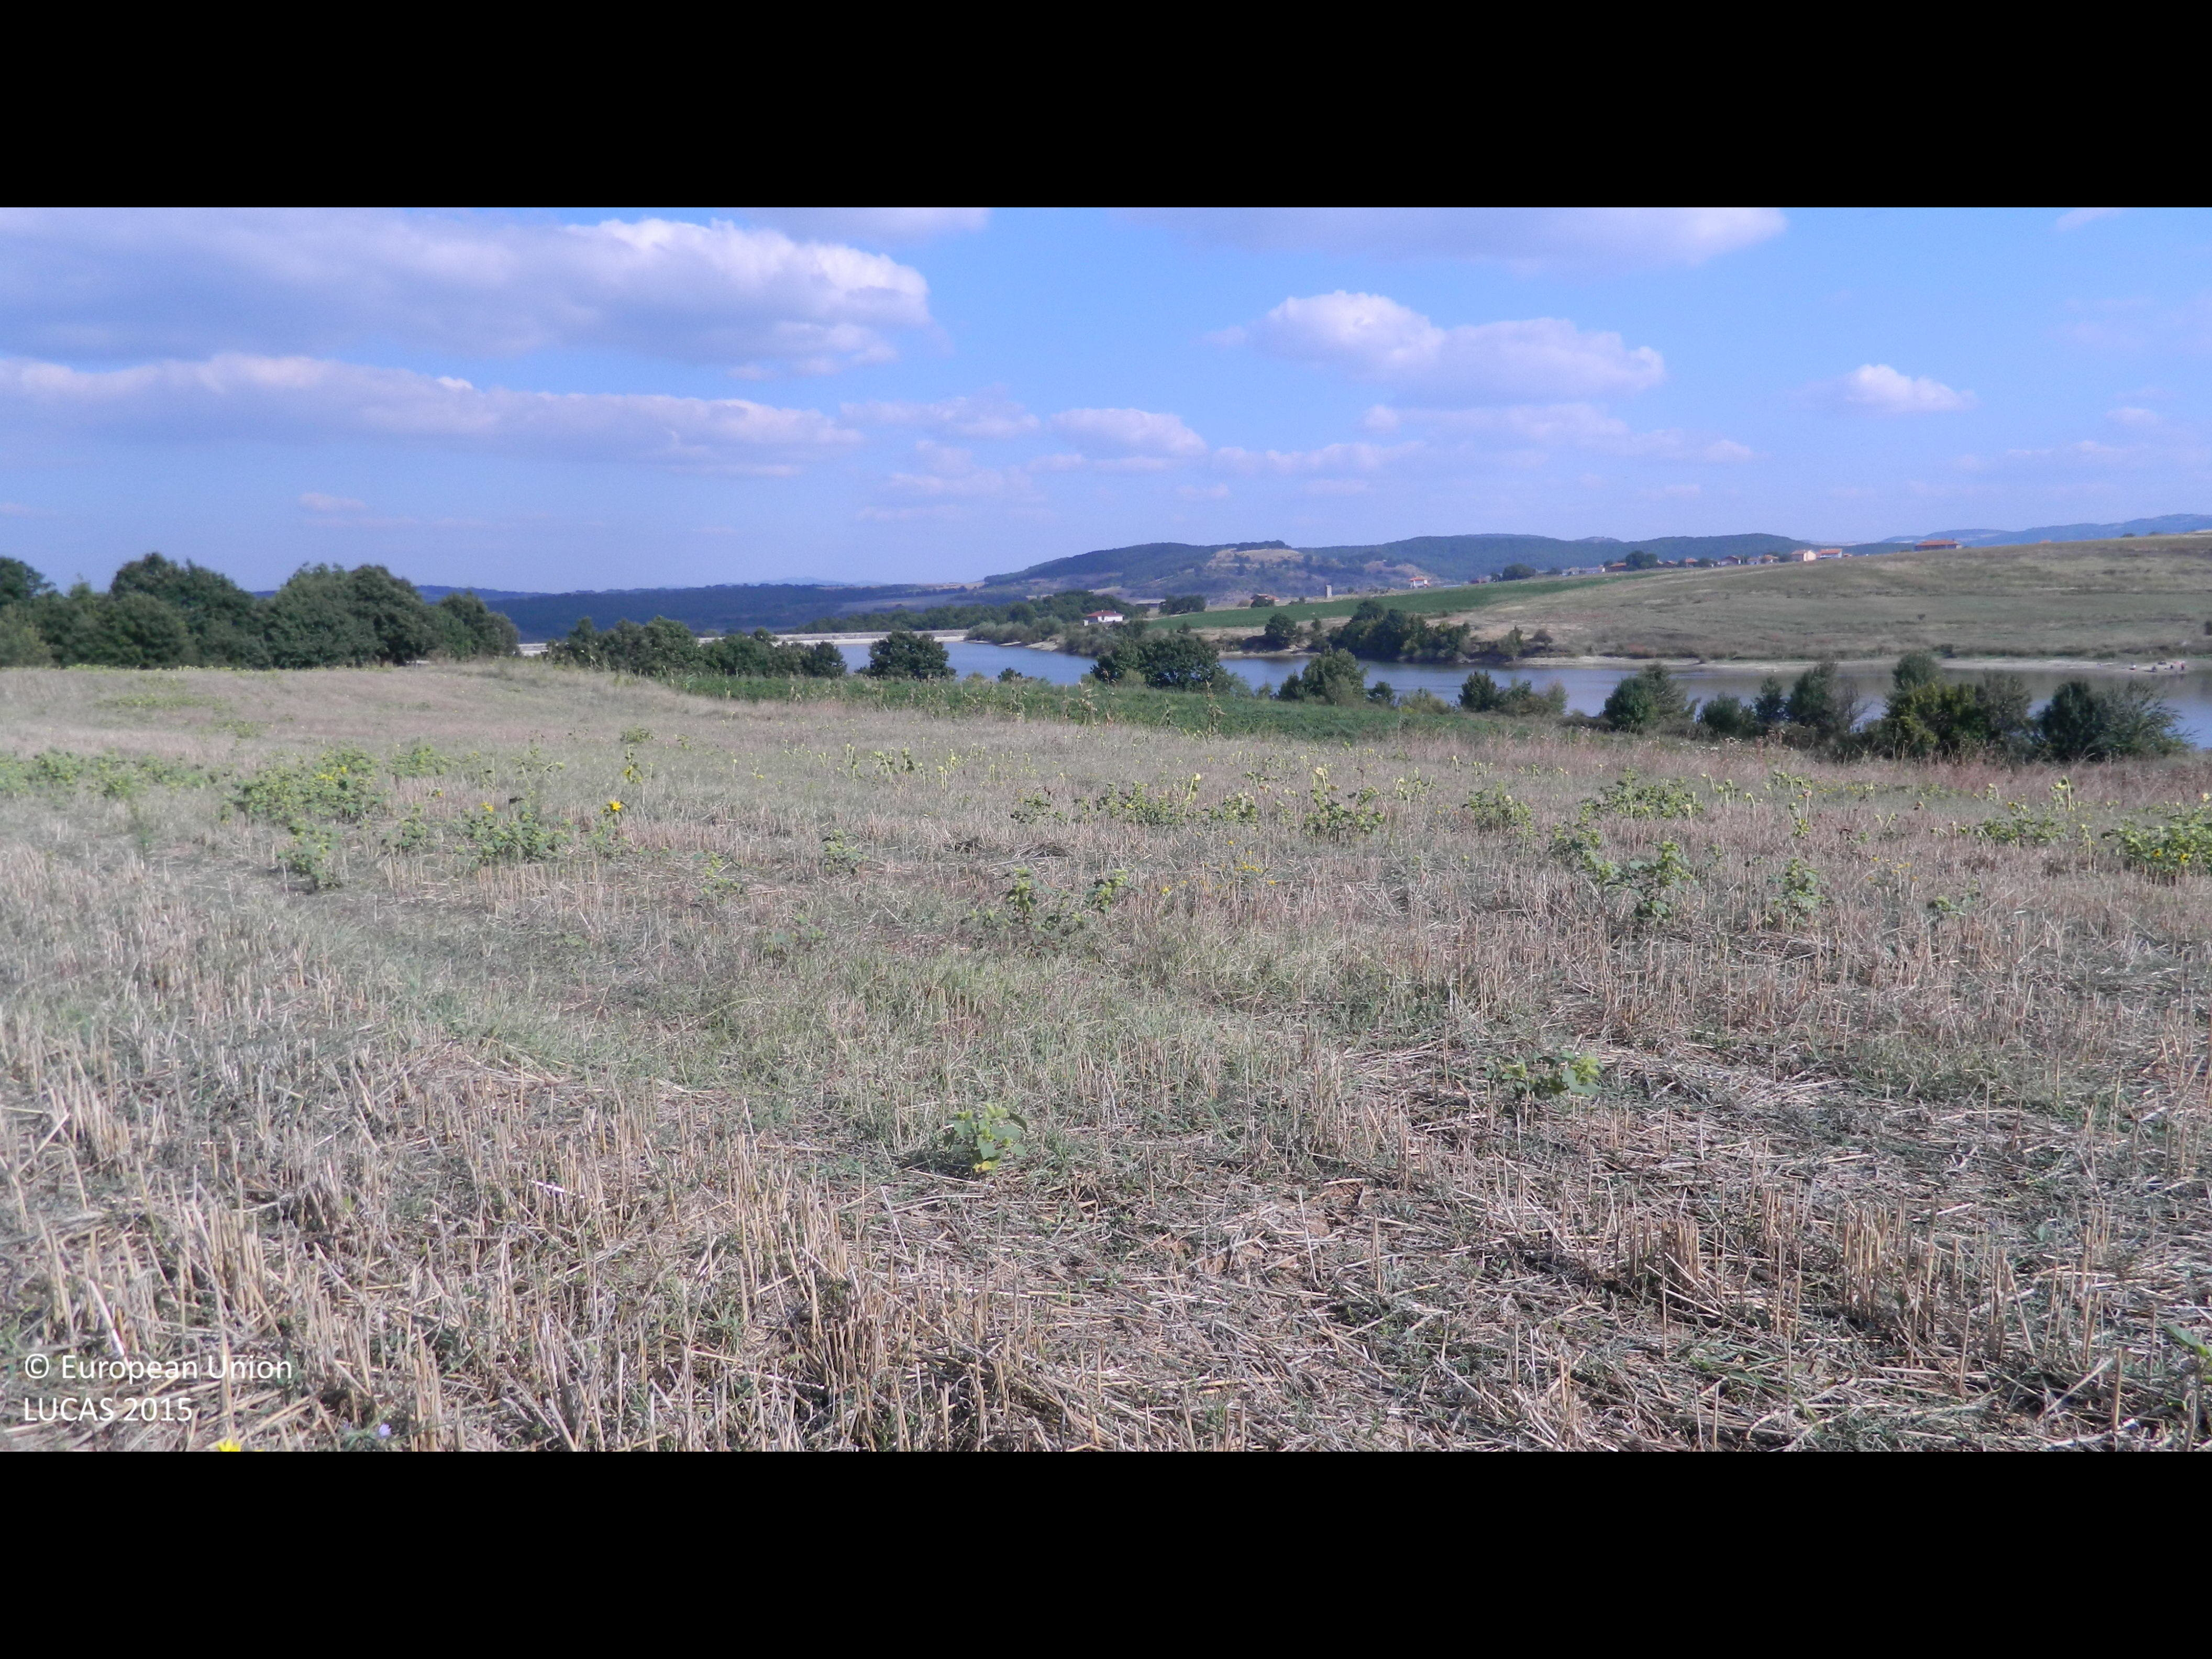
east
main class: Cropland
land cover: Common wheat
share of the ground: < 10 %
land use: Agriculture (excluding fallow land and kitchen gardens)
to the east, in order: Common wheat; Grassland without tree/shrub cover; Other fresh vegetables; Maize; Other fresh vegetables; Maize; Tracks; Broadleaved woodland; Grassland without tree/shrub cover; Grassland with sparse tree/shrub cover; Shrubland with sparse tree cover
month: September
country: BG
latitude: 41.7544
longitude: 25.5645
